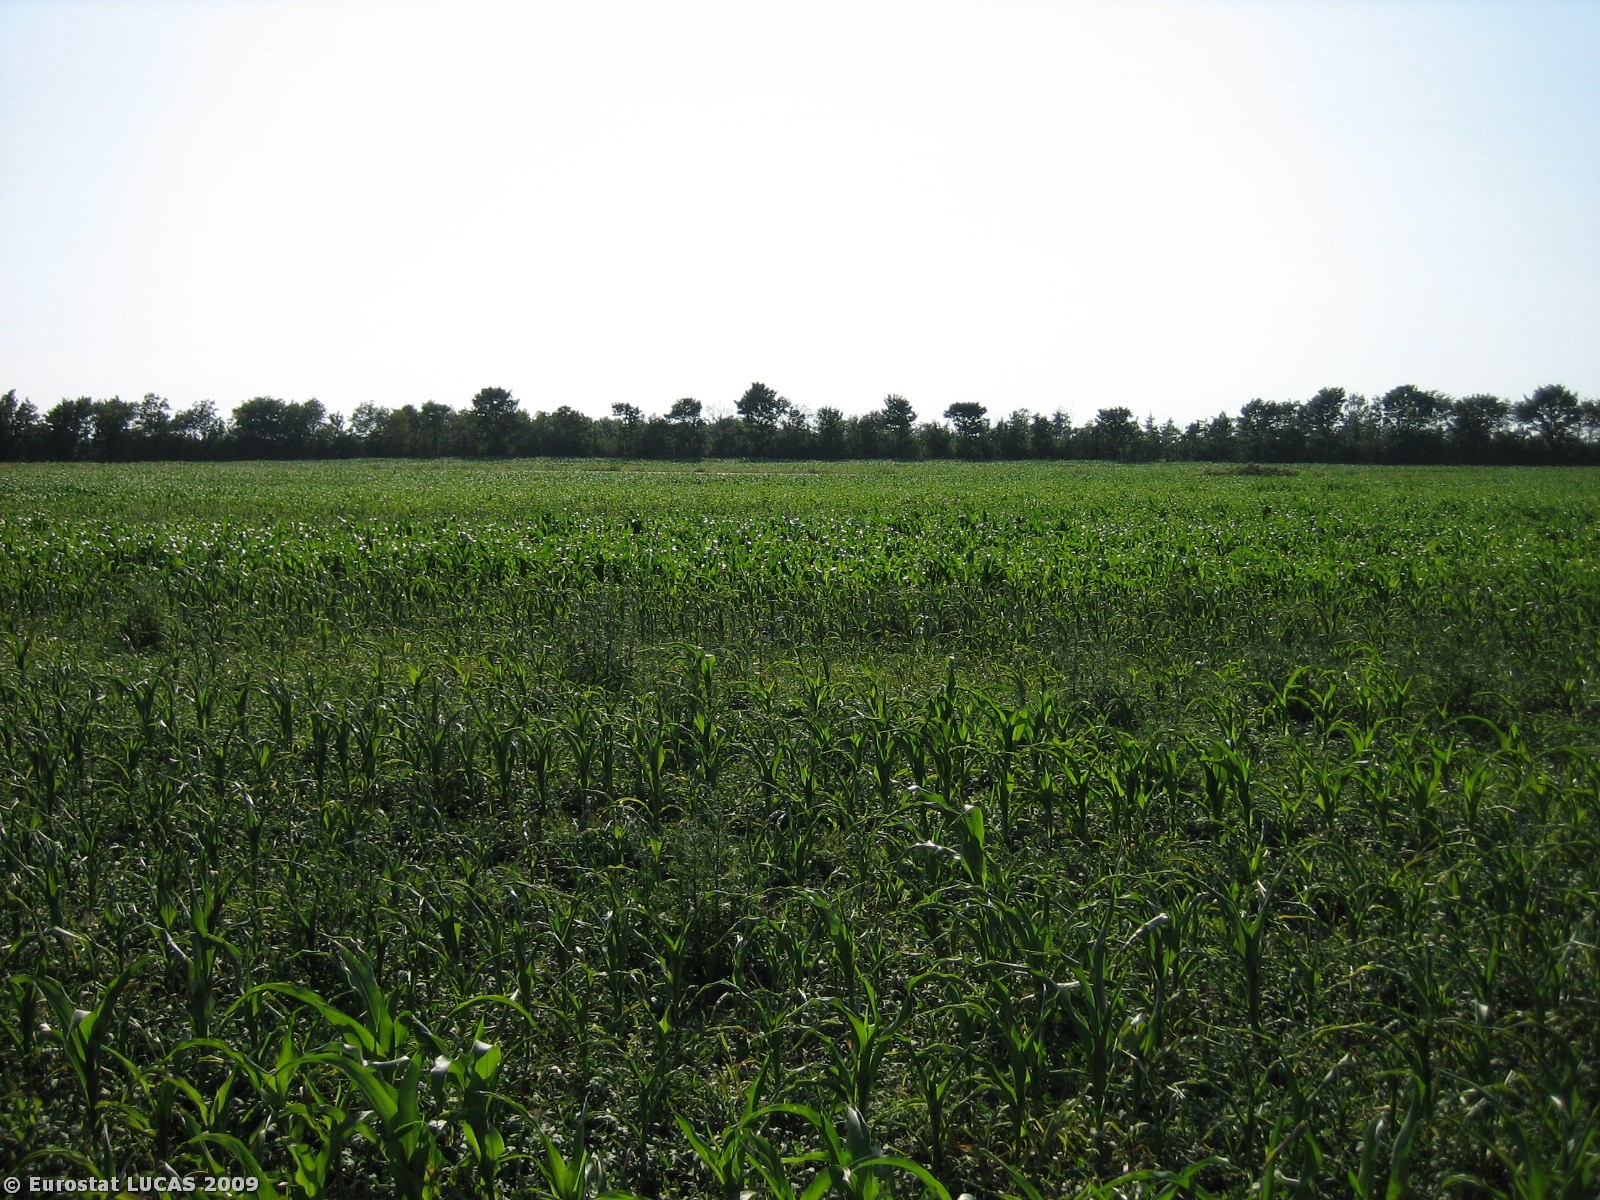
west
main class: Cropland
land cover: Maize
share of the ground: 25 - 50 %
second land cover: Dry pulses
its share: 50 - 75 %
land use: Agriculture (excluding fallow land and kitchen gardens)
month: July
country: DK
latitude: 55.3380
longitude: 8.8816
